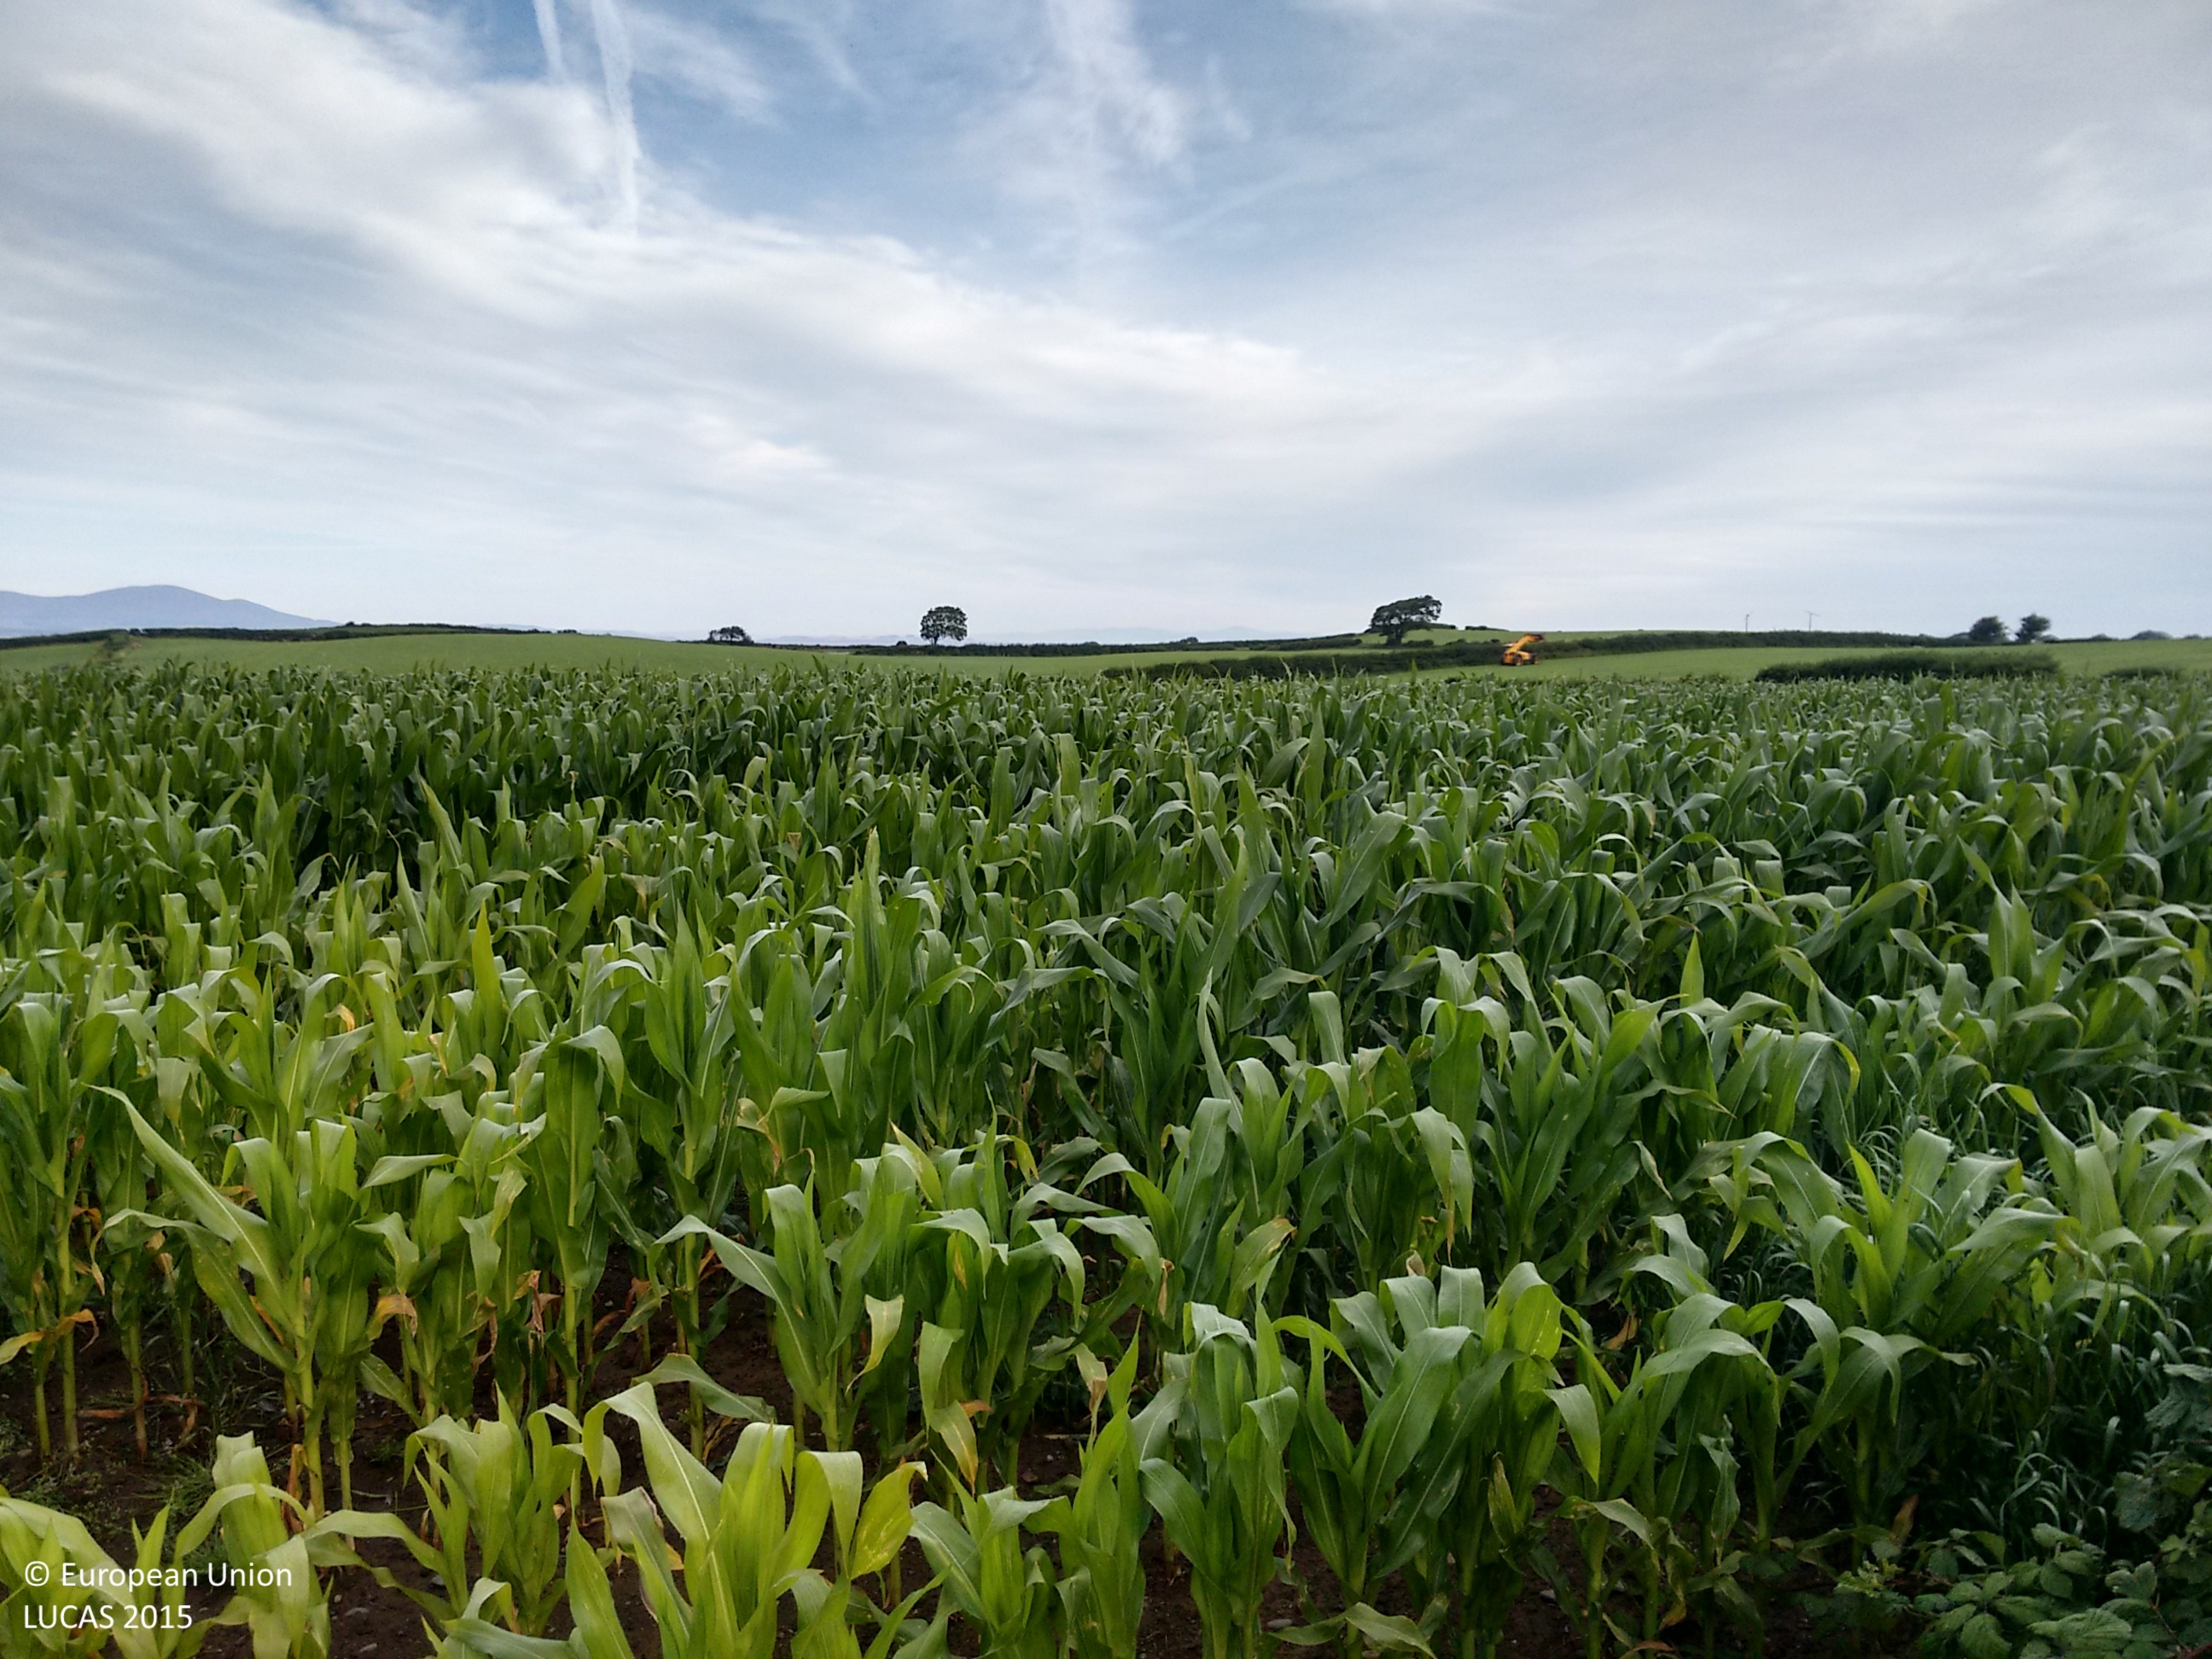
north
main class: Cropland
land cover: Maize
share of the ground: > 75 %
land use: Agriculture (excluding fallow land and kitchen gardens)
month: August
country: GB
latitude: 54.8074
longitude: -3.3813
